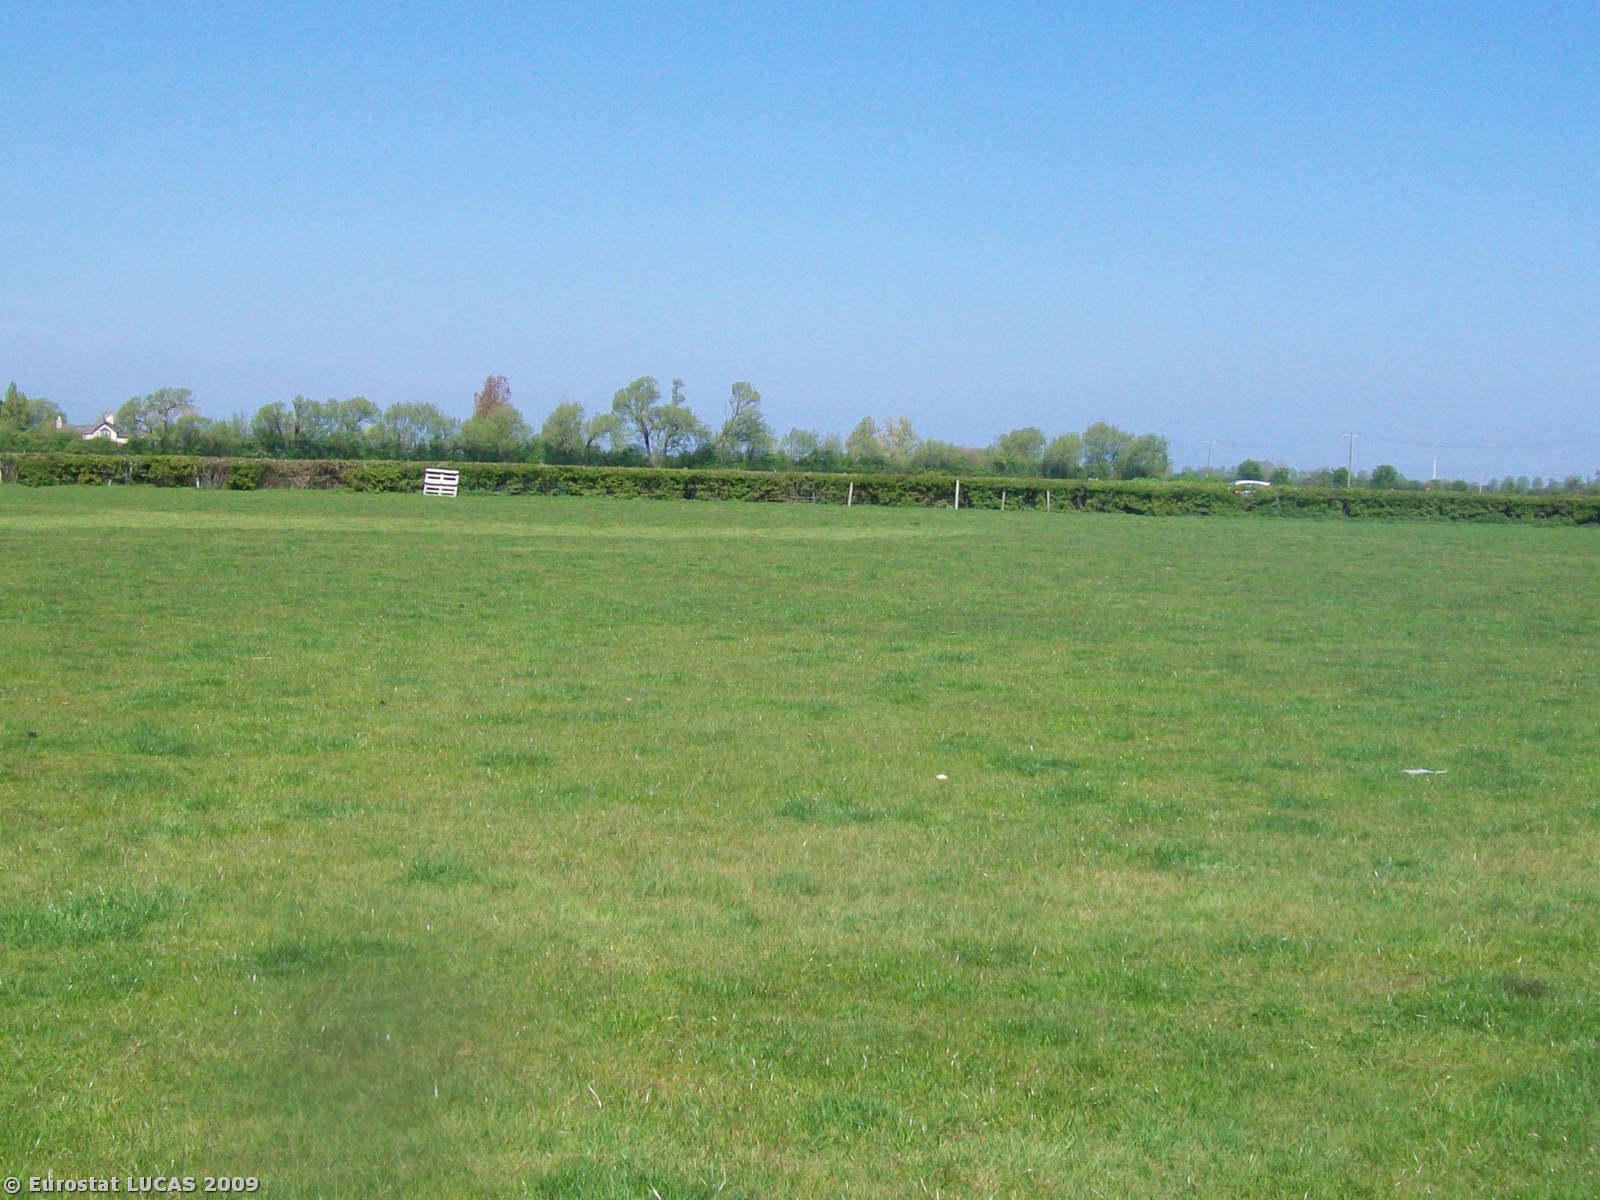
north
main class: Grassland
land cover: Grassland without tree/shrub cover
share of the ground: > 75 %
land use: Agriculture (excluding fallow land and kitchen gardens)
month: April
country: GB
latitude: 53.2791
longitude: -3.5068
